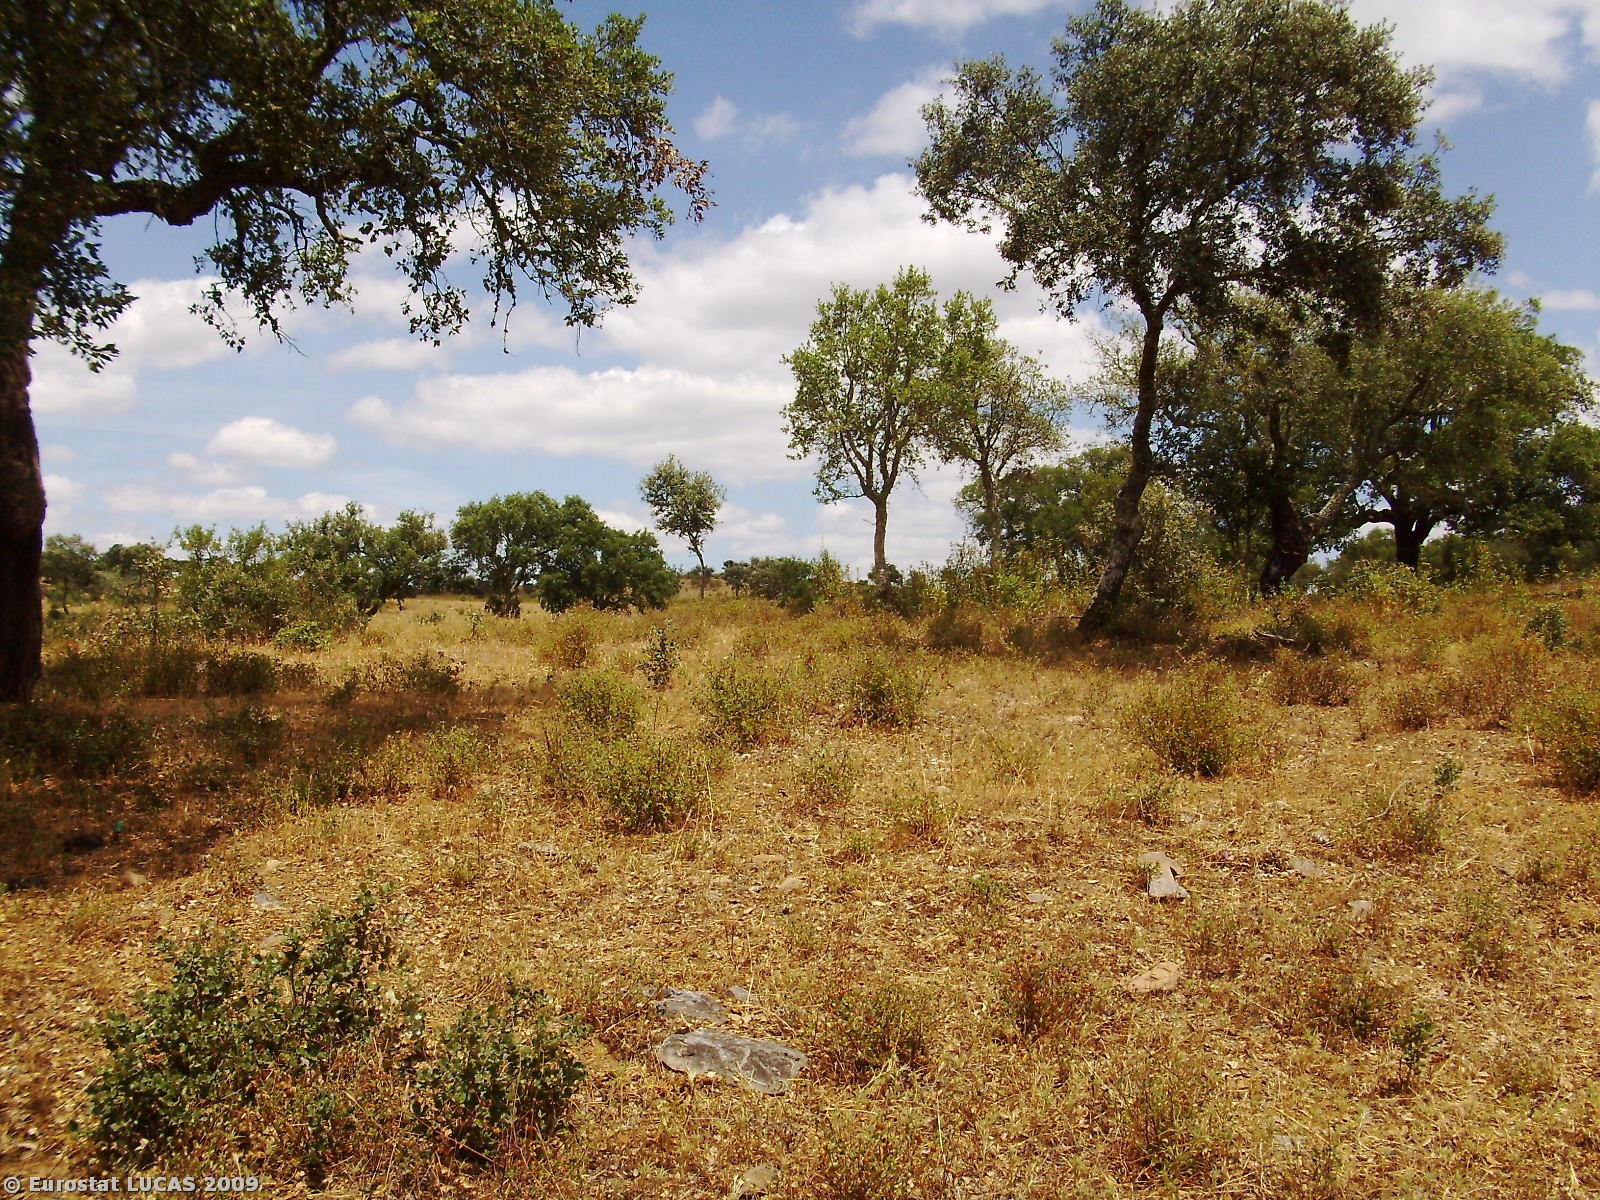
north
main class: Woodland
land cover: Broadleaved woodland
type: broadleaved evergreen forest
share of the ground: 25 - 50 %
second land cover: Spontaneously vegetated surfaces
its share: 50 - 75 %
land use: Forestry
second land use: Fallow land
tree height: > 5 m
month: June
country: PT
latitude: 38.0695
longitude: -8.4756
